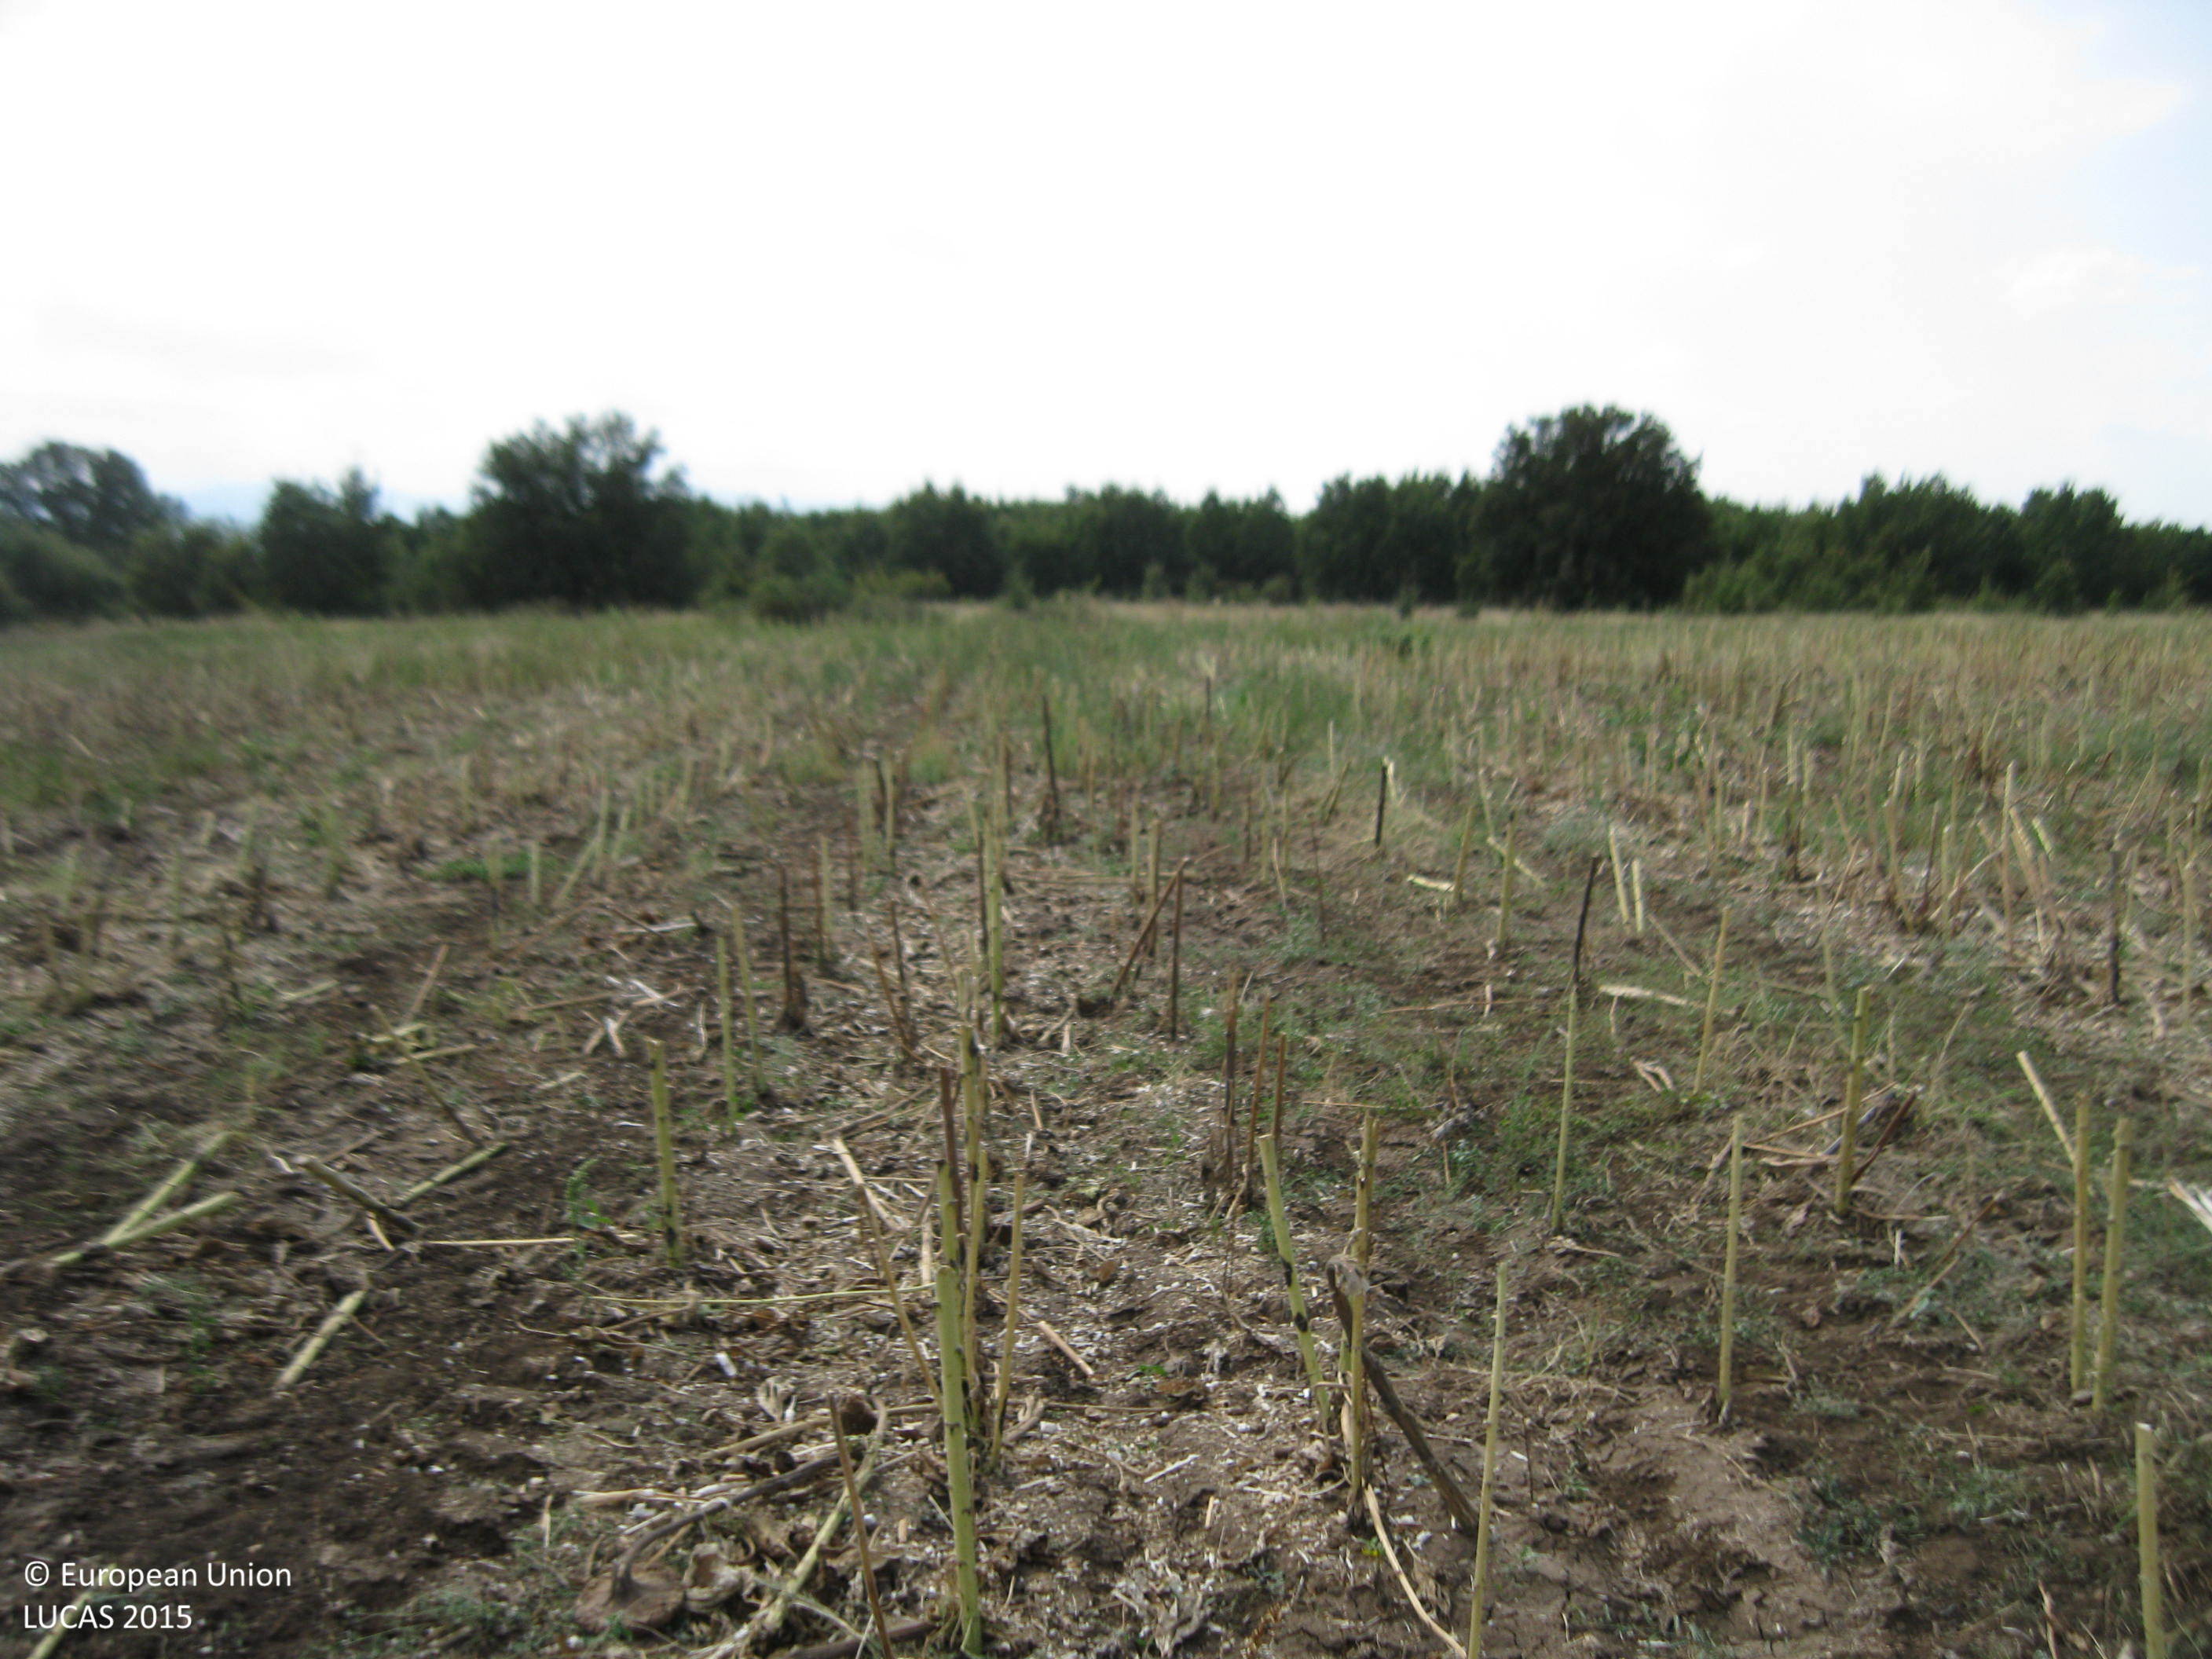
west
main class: Cropland
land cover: Sunflower
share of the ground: < 10 %
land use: Agriculture (excluding fallow land and kitchen gardens)
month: September
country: BG
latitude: 42.0996
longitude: 25.1117
